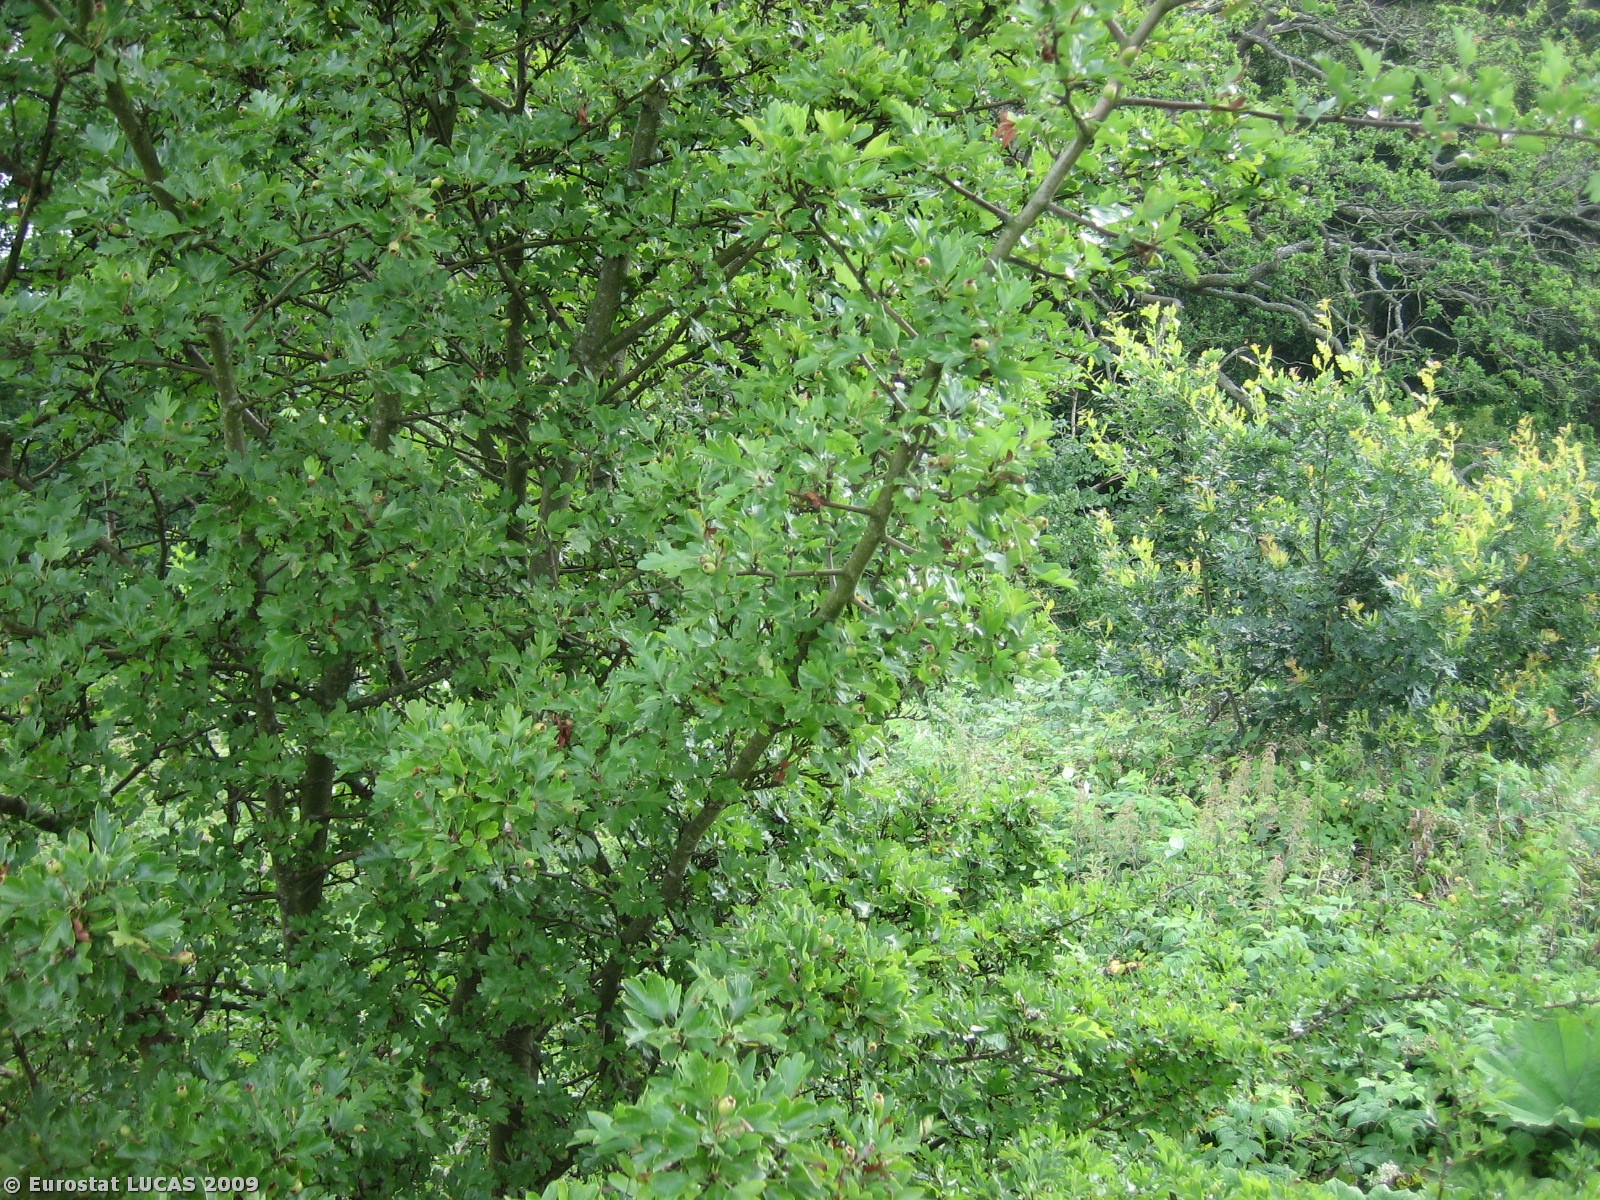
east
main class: Grassland
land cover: Grassland with sparse tree/shrub cover
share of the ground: > 75 %
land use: Unused
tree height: > 5 m
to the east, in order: Grassland with sparse tree/shrub cover; Broadleaved woodland; Rivers and streams; Broadleaved woodland; Tracks; Broadleaved woodland; Tracks; Broadleaved woodland
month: July
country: DK
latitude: 55.2171
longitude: 9.9843
